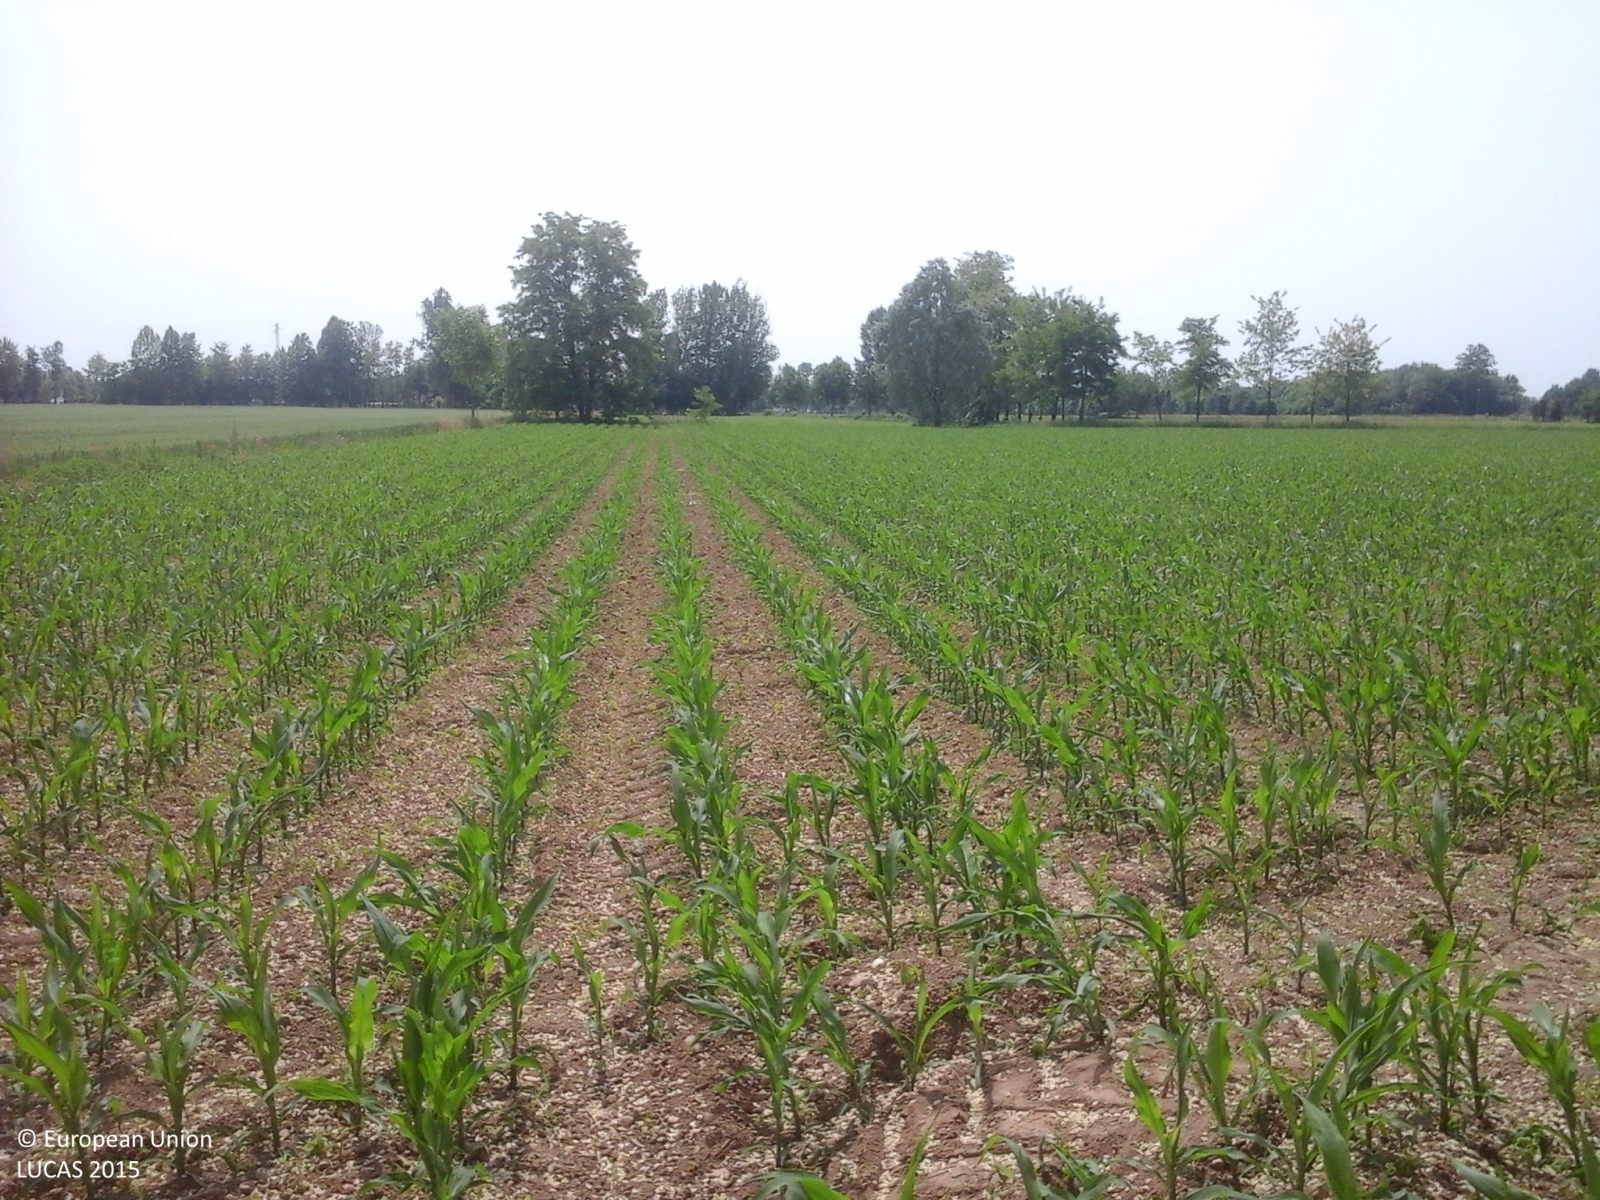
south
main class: Cropland
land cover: Maize
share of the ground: 10 - 25 %
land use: Agriculture (excluding fallow land and kitchen gardens)
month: May
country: IT
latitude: 45.6521
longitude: 11.7553
